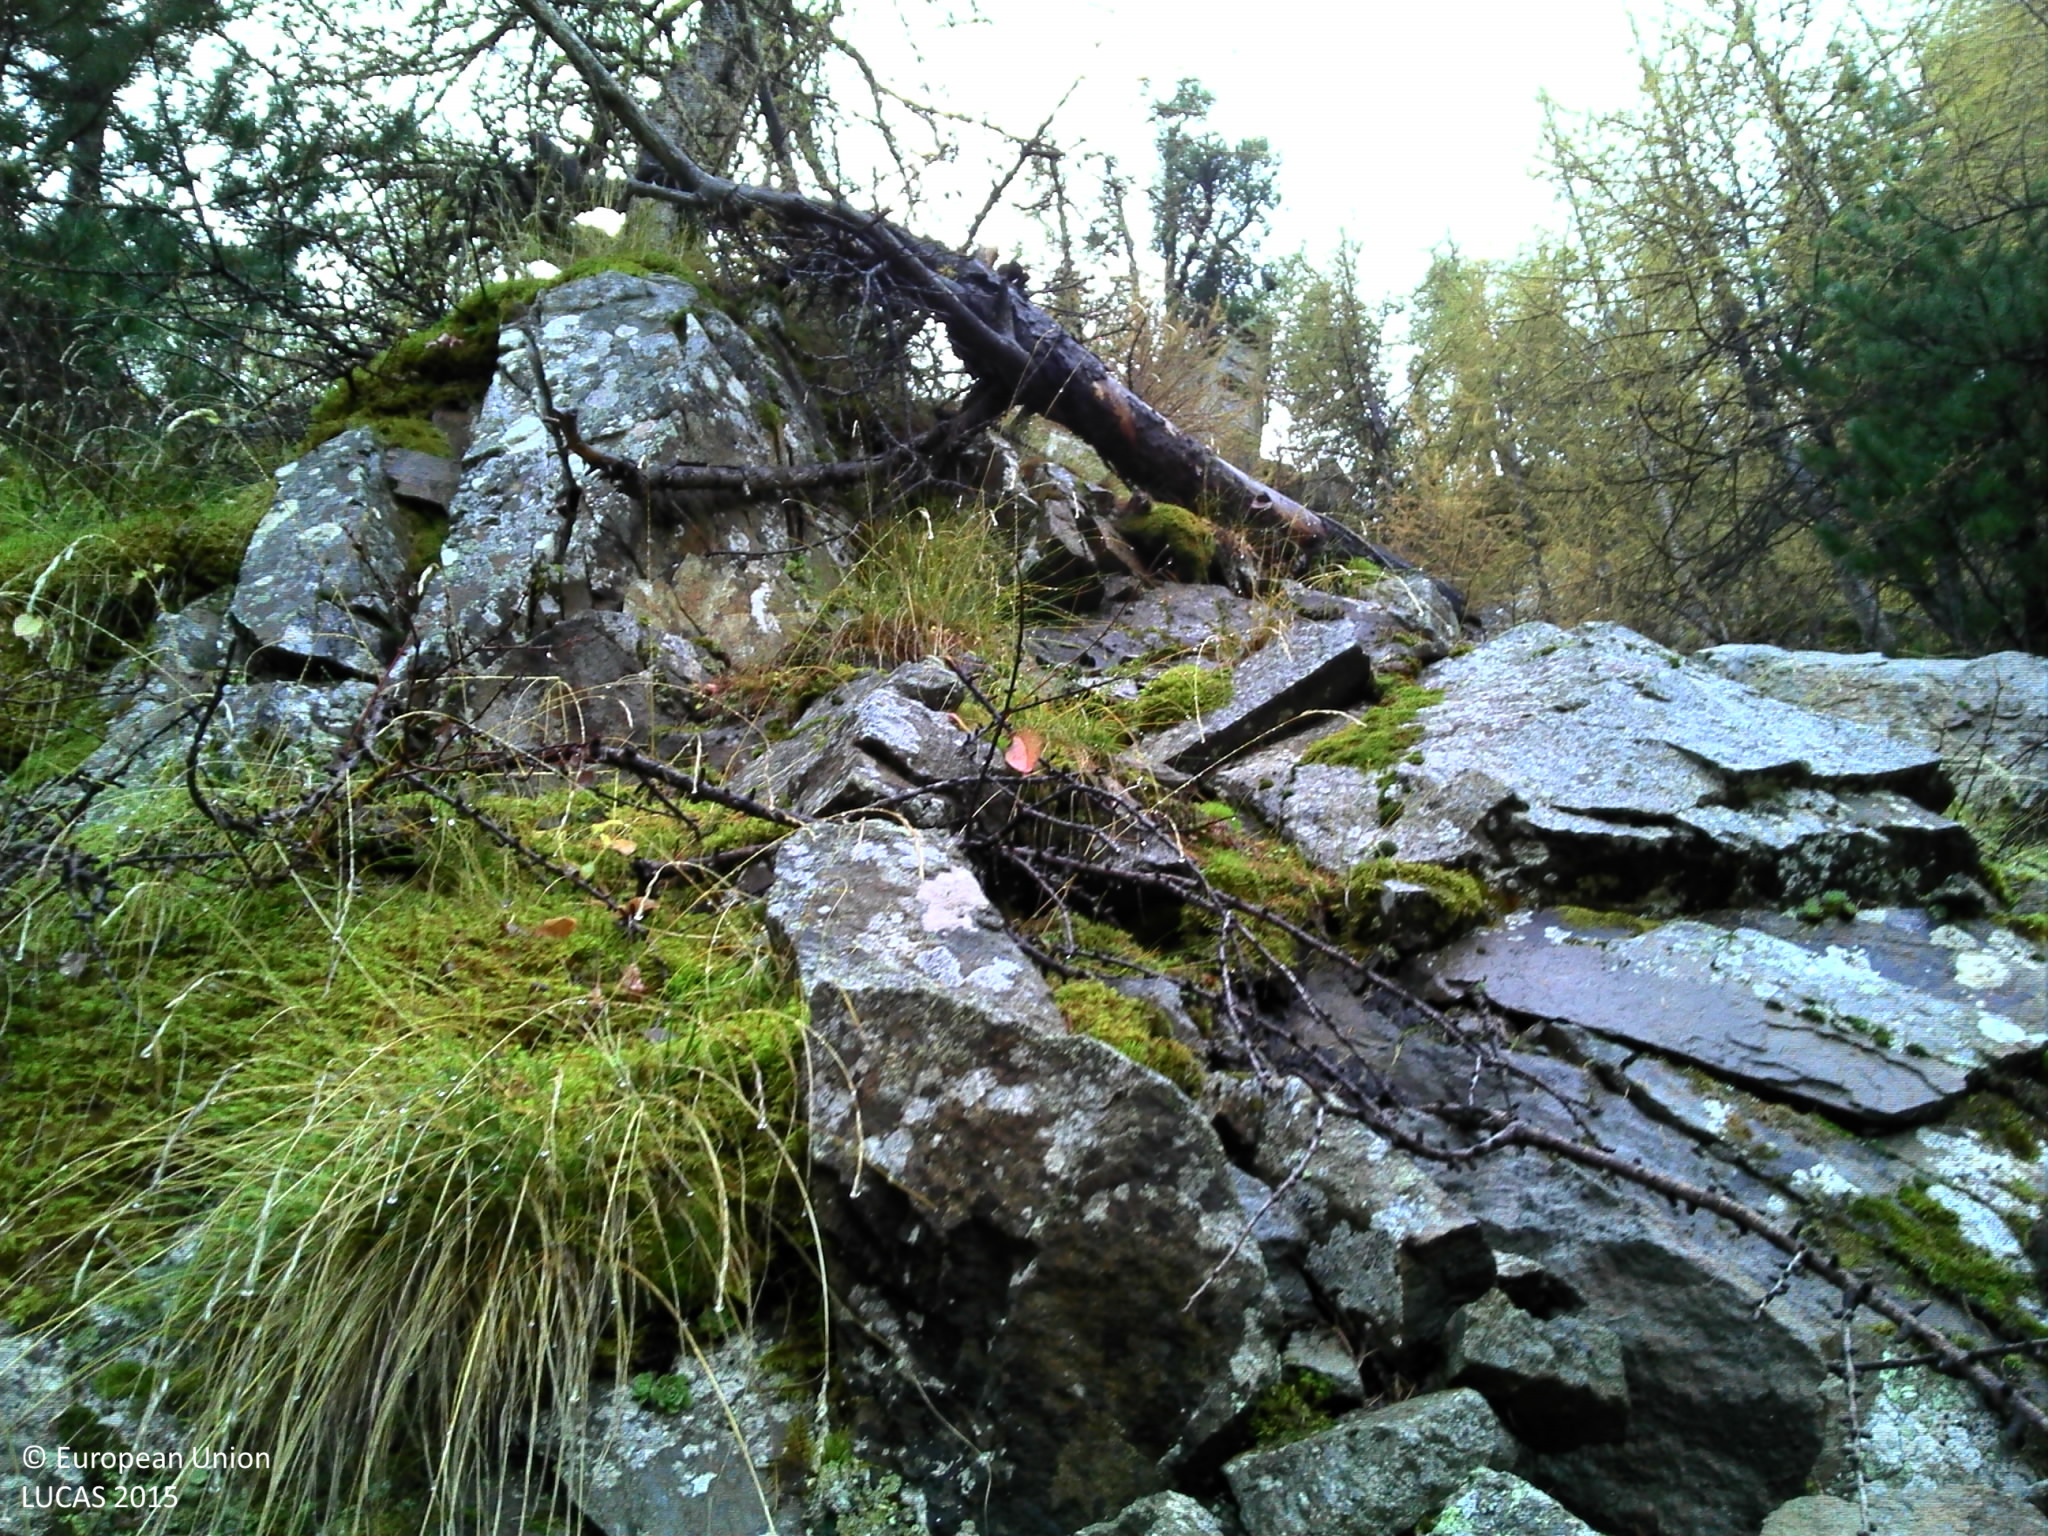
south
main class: Woodland
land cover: Pine dominated coniferous woodland
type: alpine coniferous forest
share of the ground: > 75 %
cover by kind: coniferous forest trees 70 %, herbaceous plants 15 %, consolidated bare surface 15 %
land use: Semi-natural and natural areas not in use
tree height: > 5 m
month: October
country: FR
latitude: 45.0328
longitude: 6.5401
